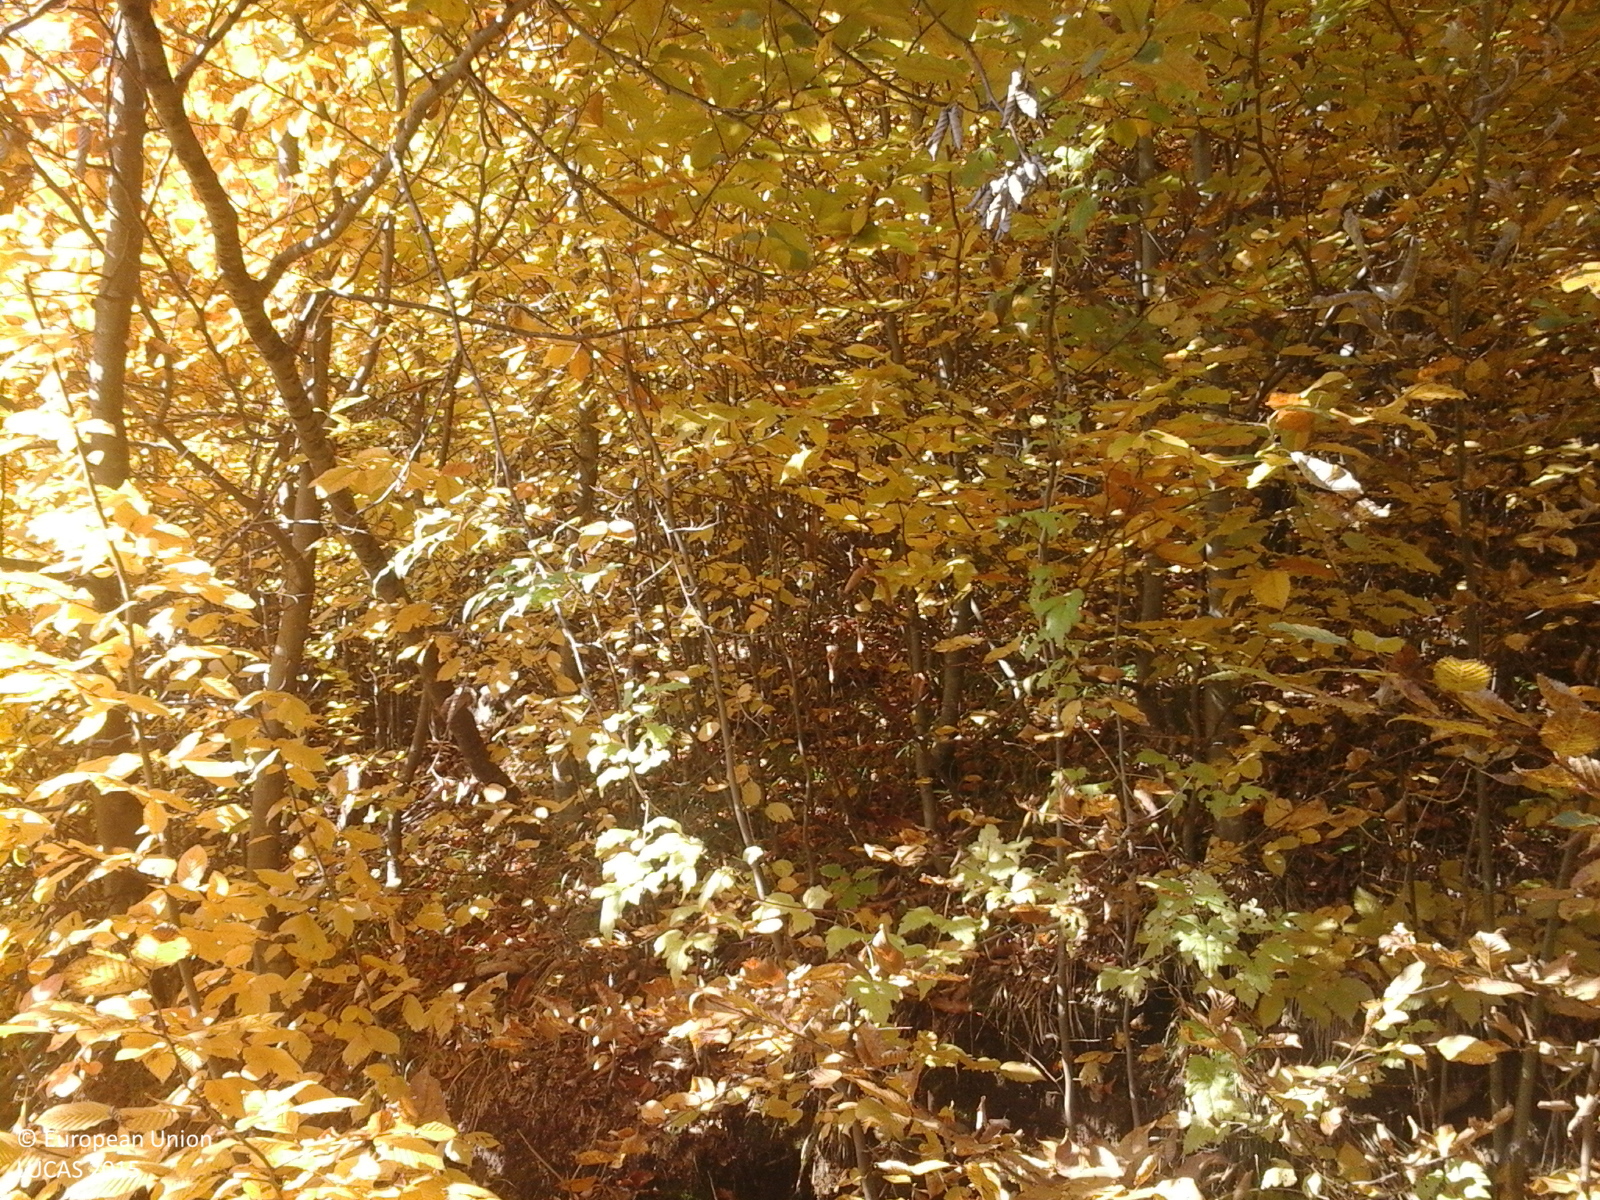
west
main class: Woodland
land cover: Broadleaved woodland
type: beech forest
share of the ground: > 75 %
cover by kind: broadleaved forest trees 100 %
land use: Forestry
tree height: > 5 m
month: October
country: RO
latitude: 46.0391
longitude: 26.6878
